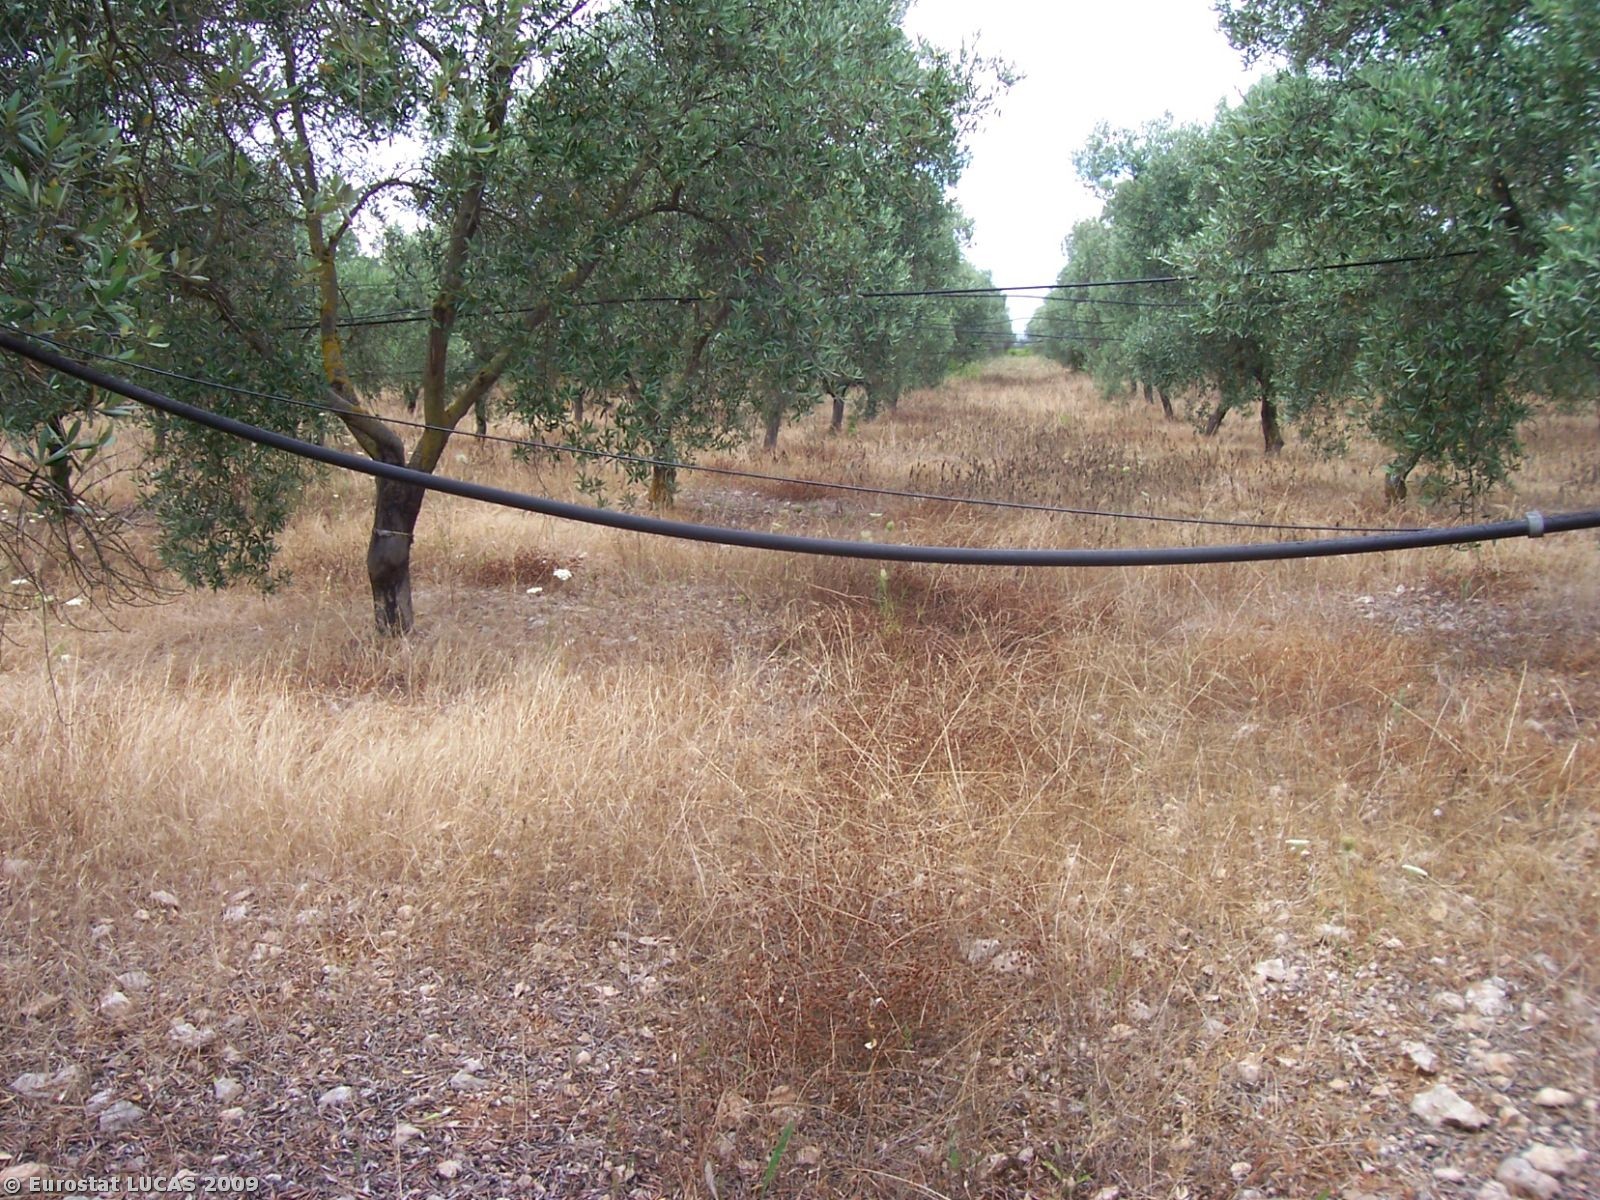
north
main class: Cropland
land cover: Olive groves
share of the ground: 25 - 50 %
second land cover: Spontaneously vegetated surfaces
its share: > 75 %
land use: Agriculture (excluding fallow land and kitchen gardens)
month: June
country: IT
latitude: 40.3057
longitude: 17.5164
